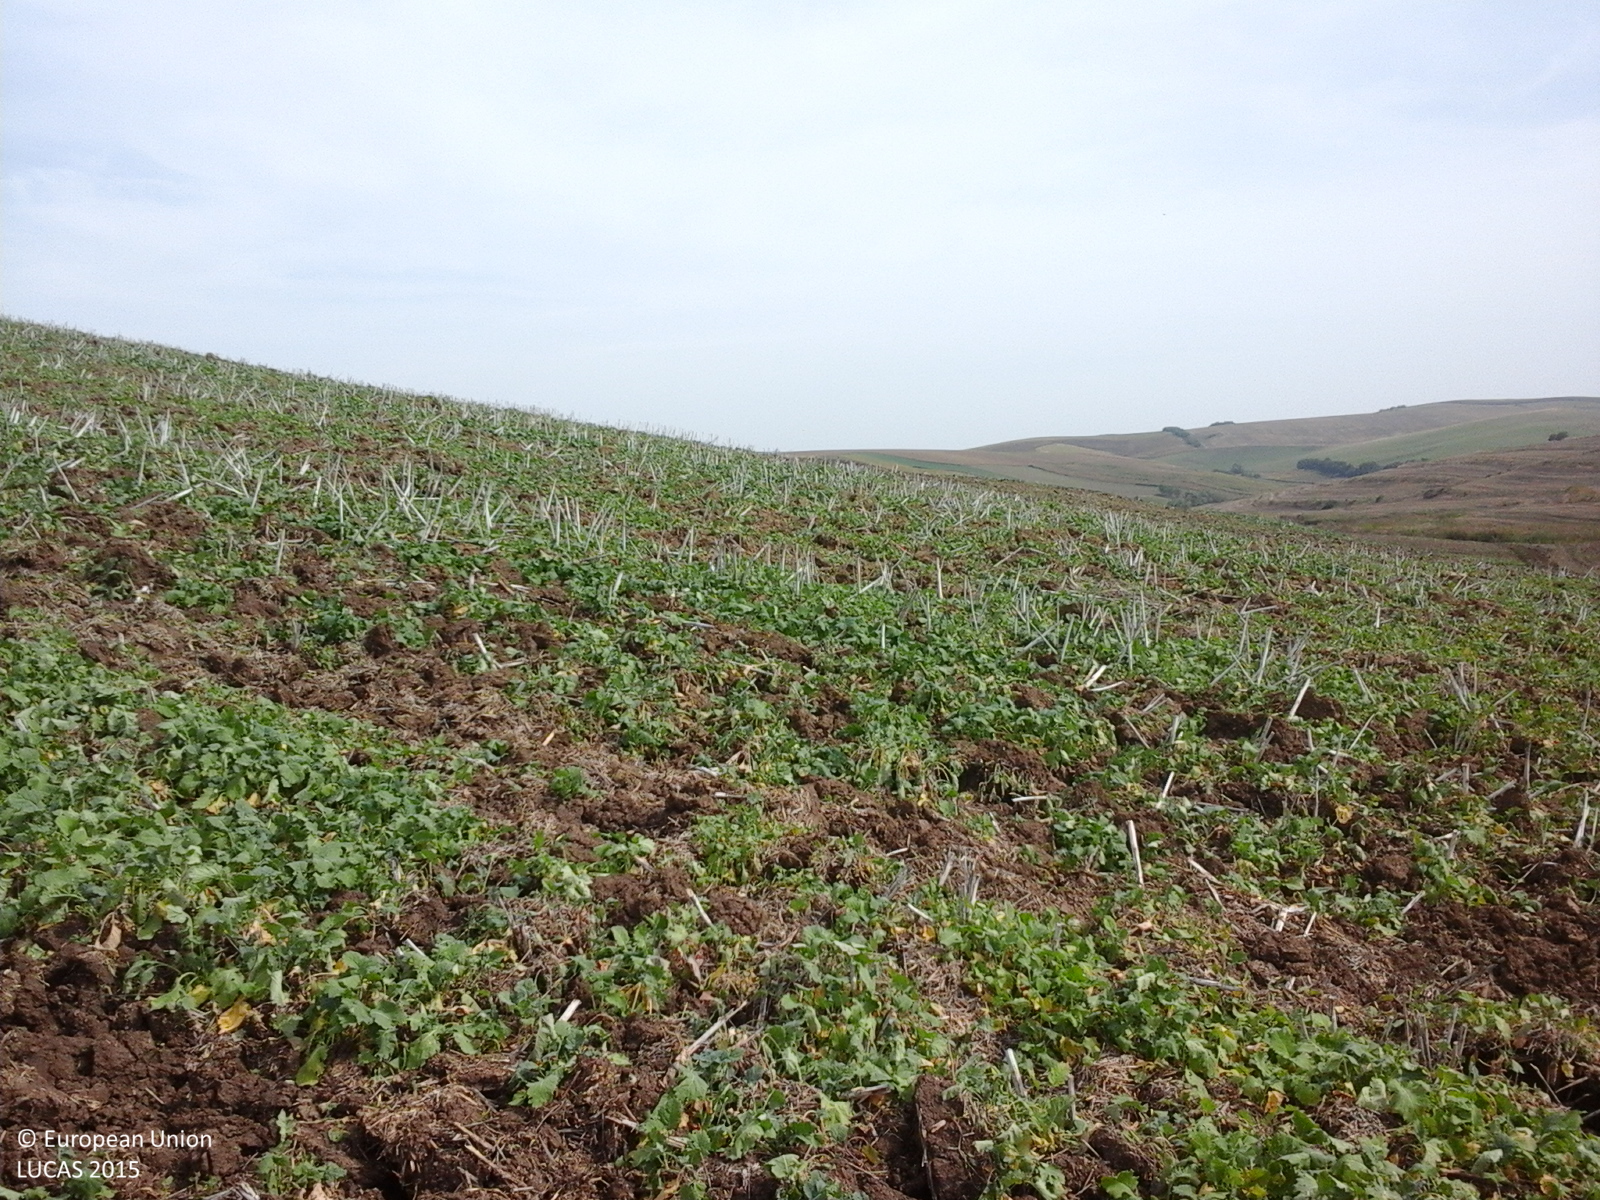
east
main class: Cropland
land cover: Rape and turnip rape
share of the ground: 25 - 50 %
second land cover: Spontaneously vegetated surfaces
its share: 50 - 75 %
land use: Agriculture (excluding fallow land and kitchen gardens)
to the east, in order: Rape and turnip rape; Spontaneously vegetated surfaces
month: September
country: RO
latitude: 46.6203
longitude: 23.7990
